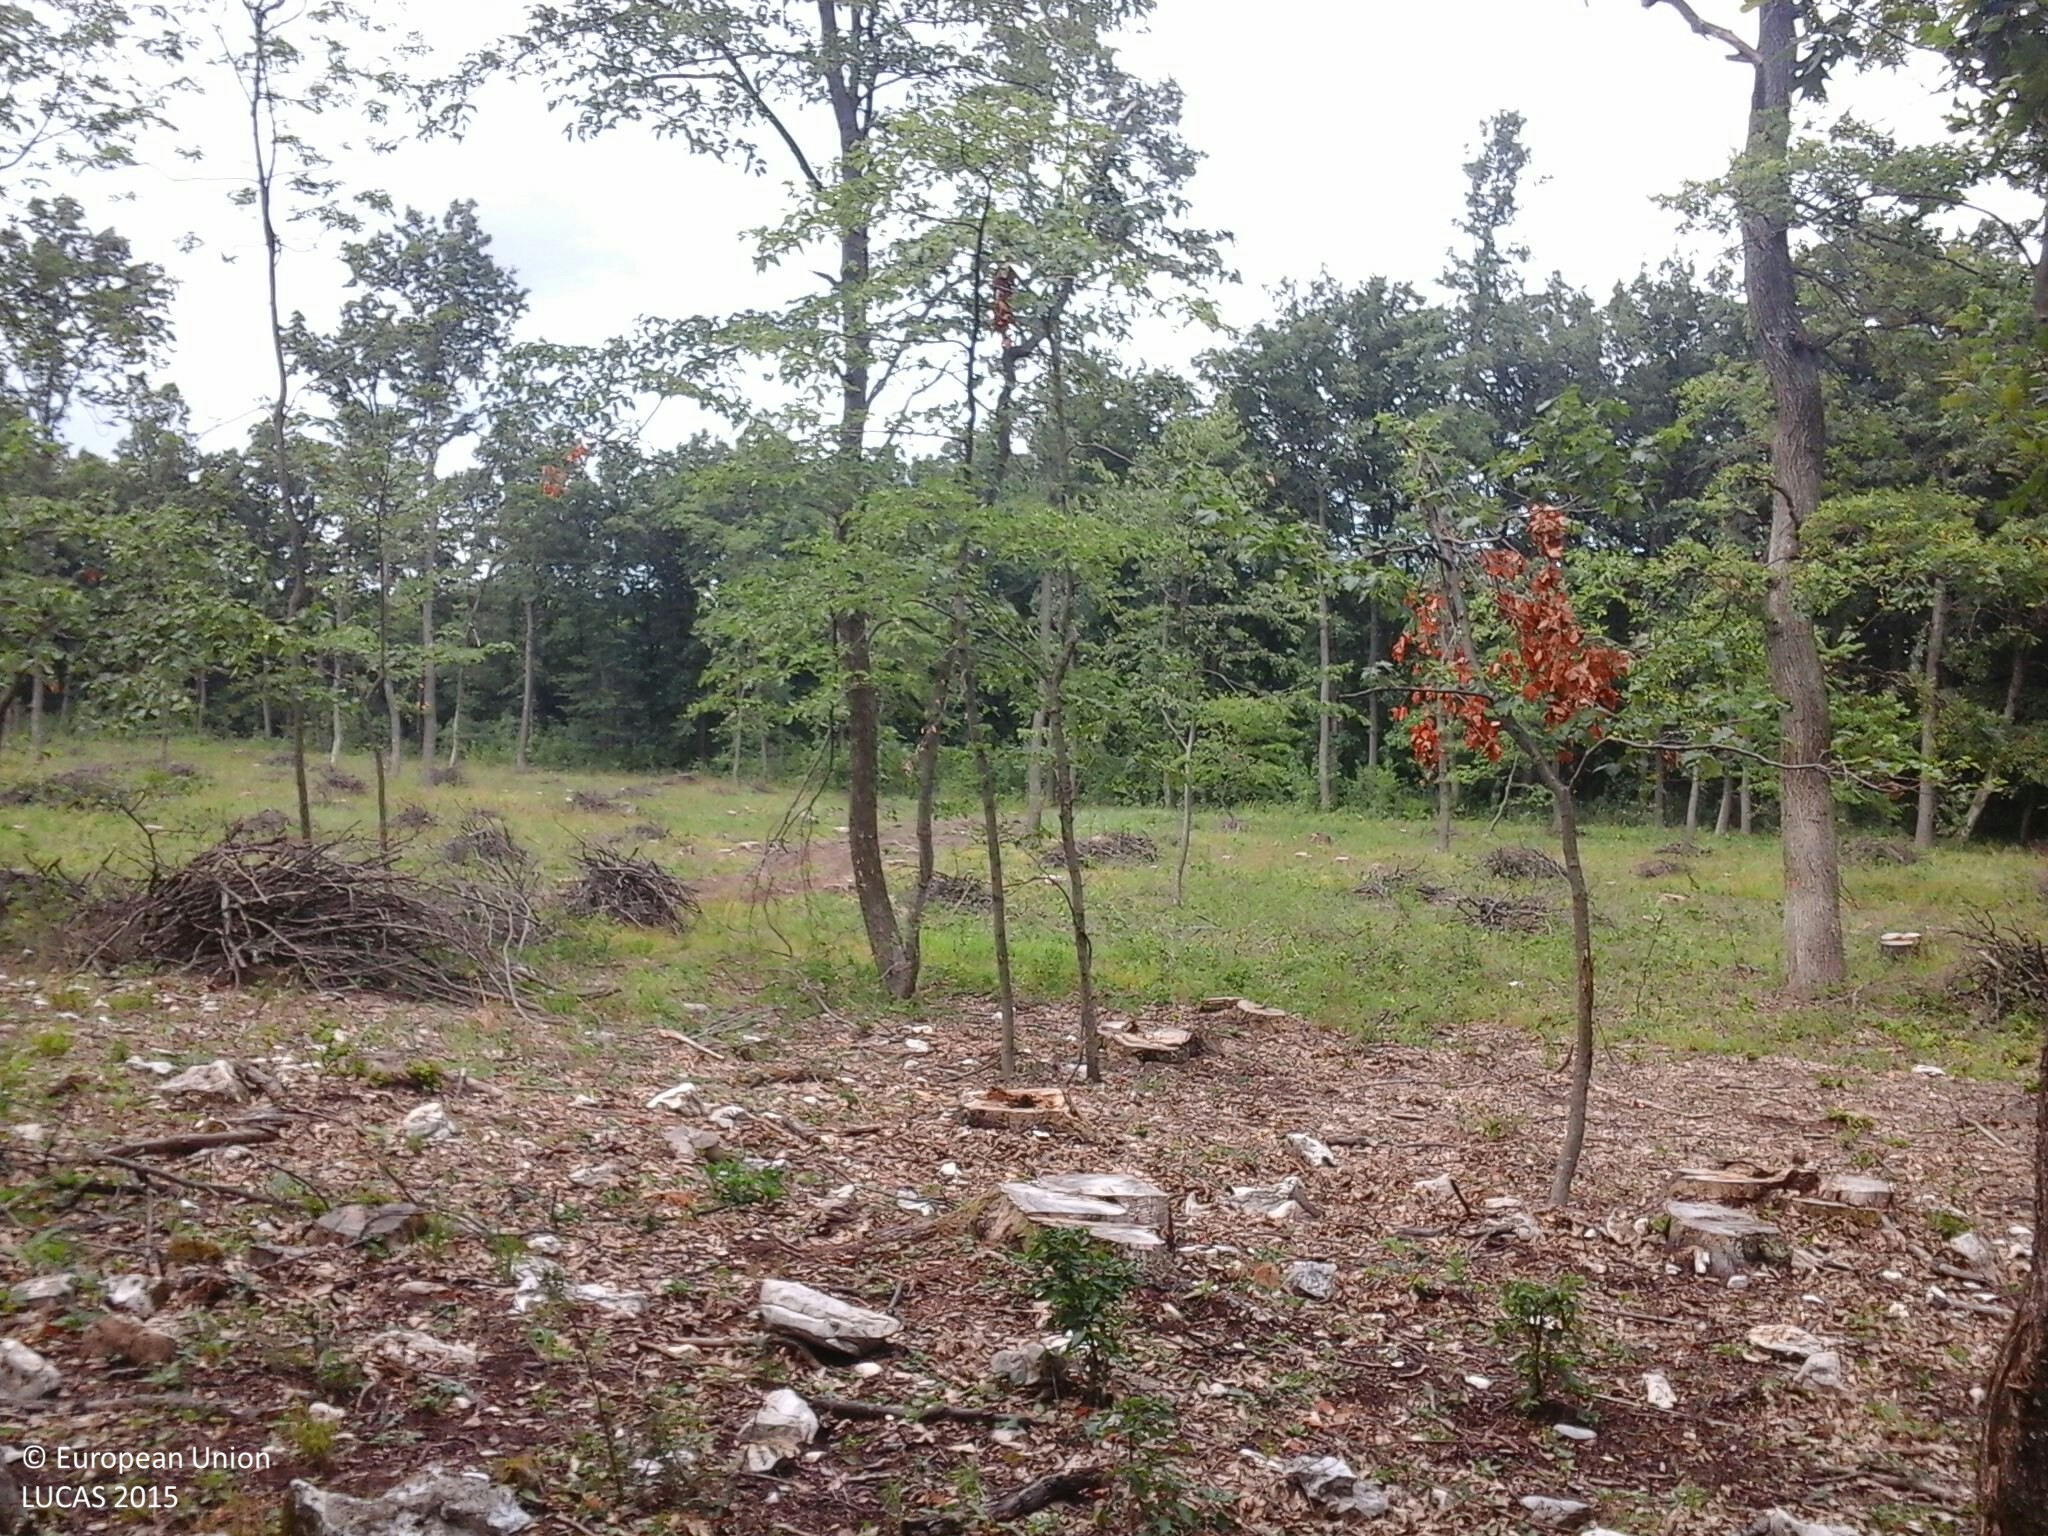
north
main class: Woodland
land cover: Broadleaved woodland
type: acidophilous oak and oak-birch forest
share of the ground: 50 - 75 %
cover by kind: broadleaved forest trees 75 %, herbaceous plants 15 %, consolidated bare surface 10 %
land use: Forestry
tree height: > 5 m
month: July
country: HU
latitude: 46.9563
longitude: 17.7473
